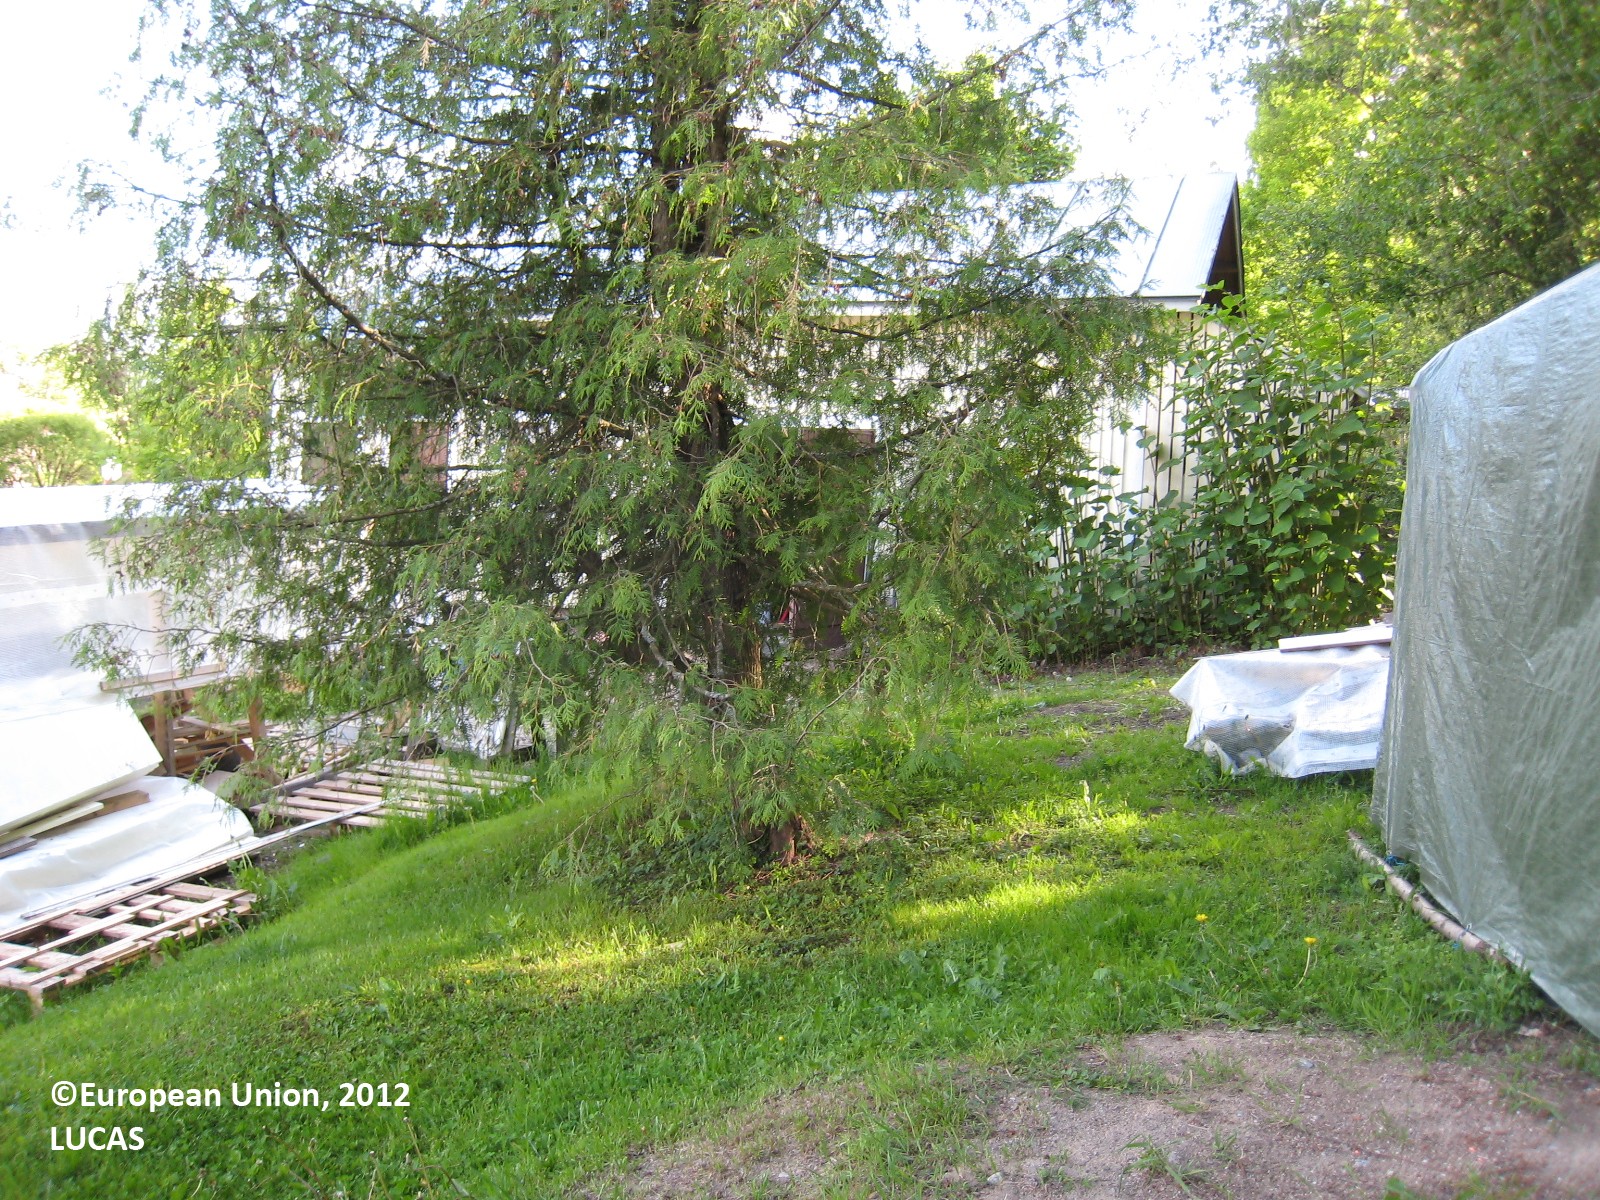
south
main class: Grassland
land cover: Grassland with sparse tree/shrub cover
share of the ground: > 75 %
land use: Residential
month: June
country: FI
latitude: 62.2448
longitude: 25.8487
